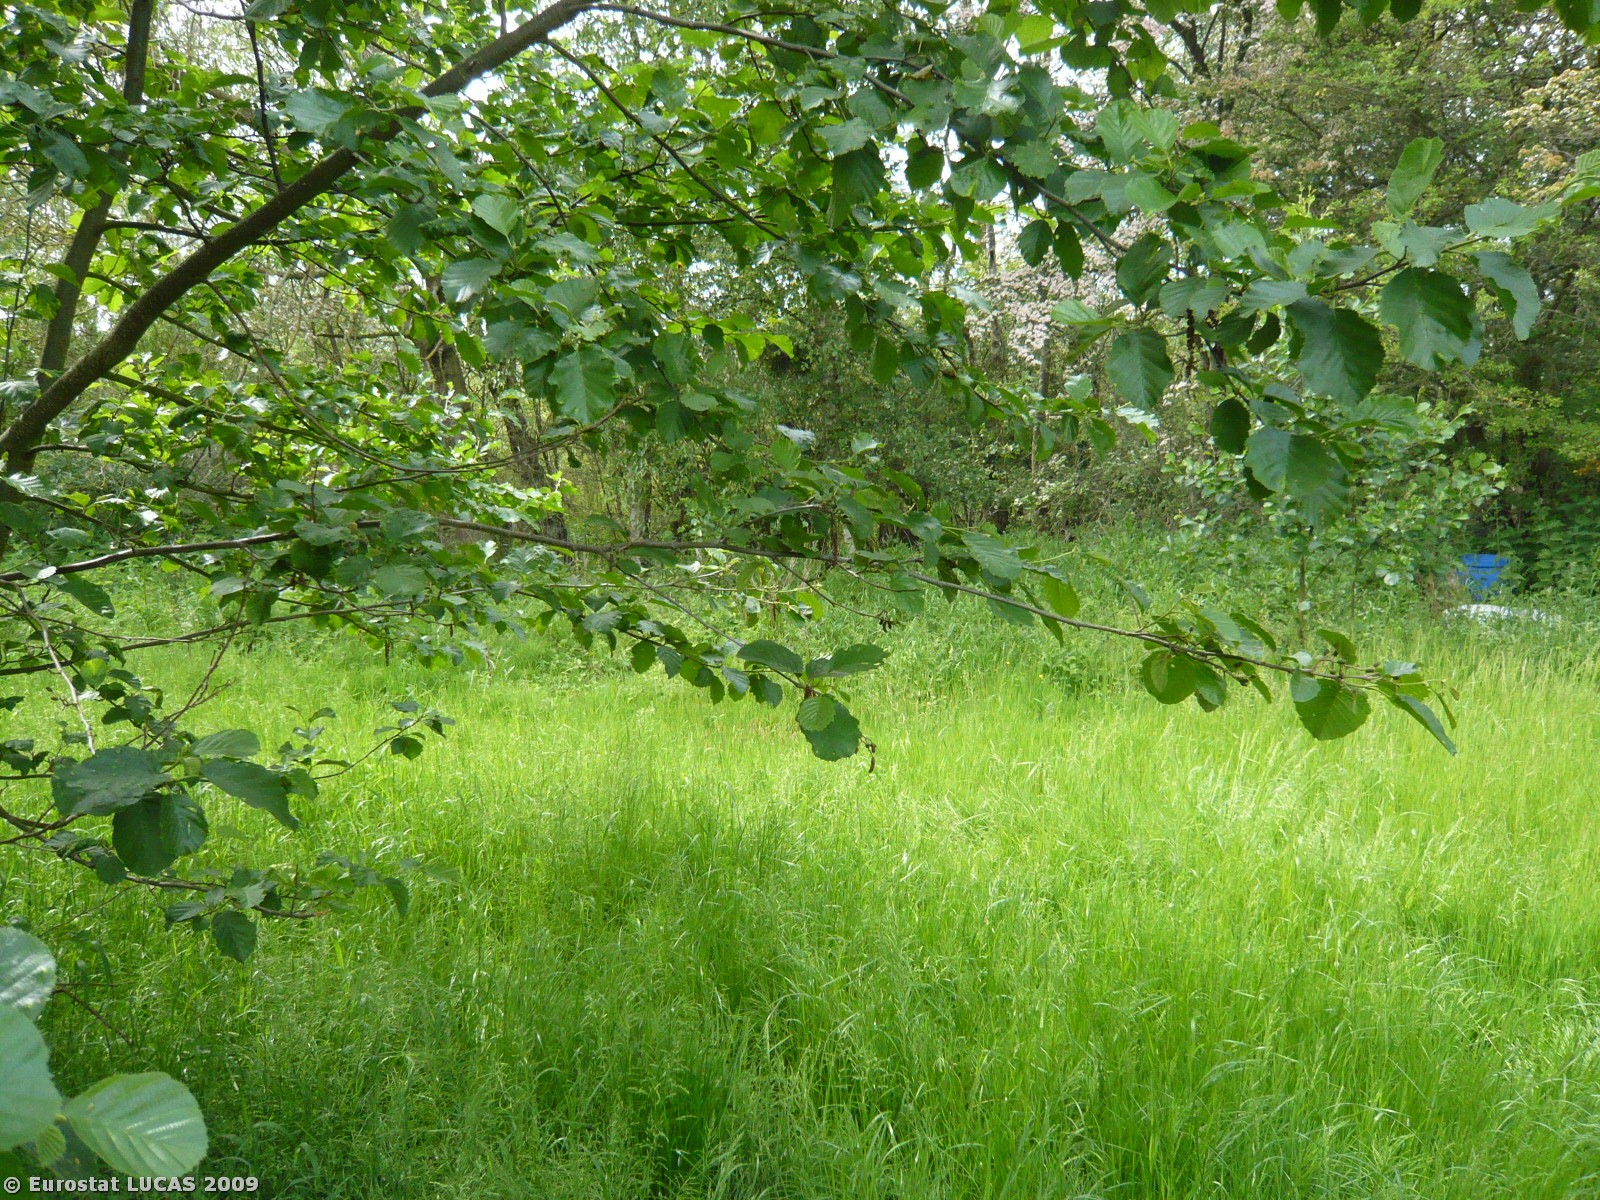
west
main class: Woodland
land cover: Broadleaved woodland
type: mire and swamp forests
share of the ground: > 75 %
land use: Unused
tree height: > 5 m
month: June
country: DK
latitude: 55.2456
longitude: 11.3673
